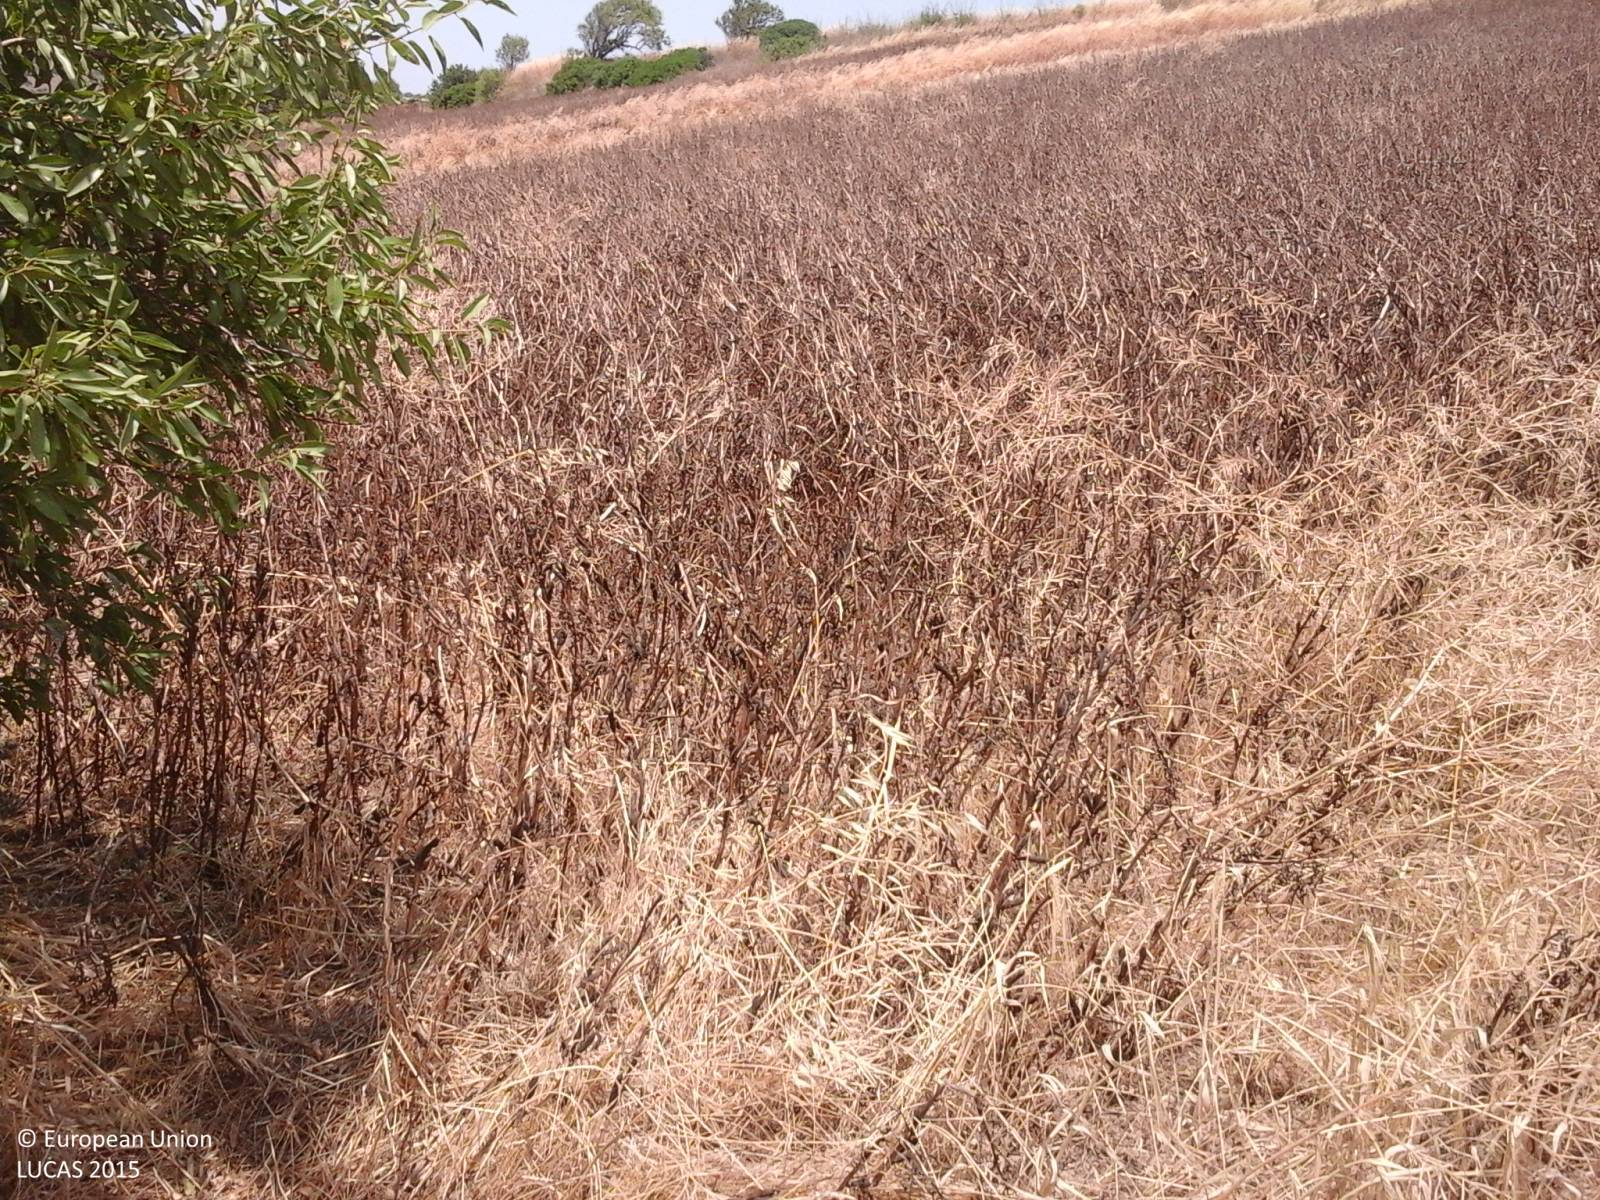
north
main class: Cropland
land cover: Barley
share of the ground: > 75 %
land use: Agriculture (excluding fallow land and kitchen gardens)
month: July
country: IT
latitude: 39.6084
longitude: 8.8305
